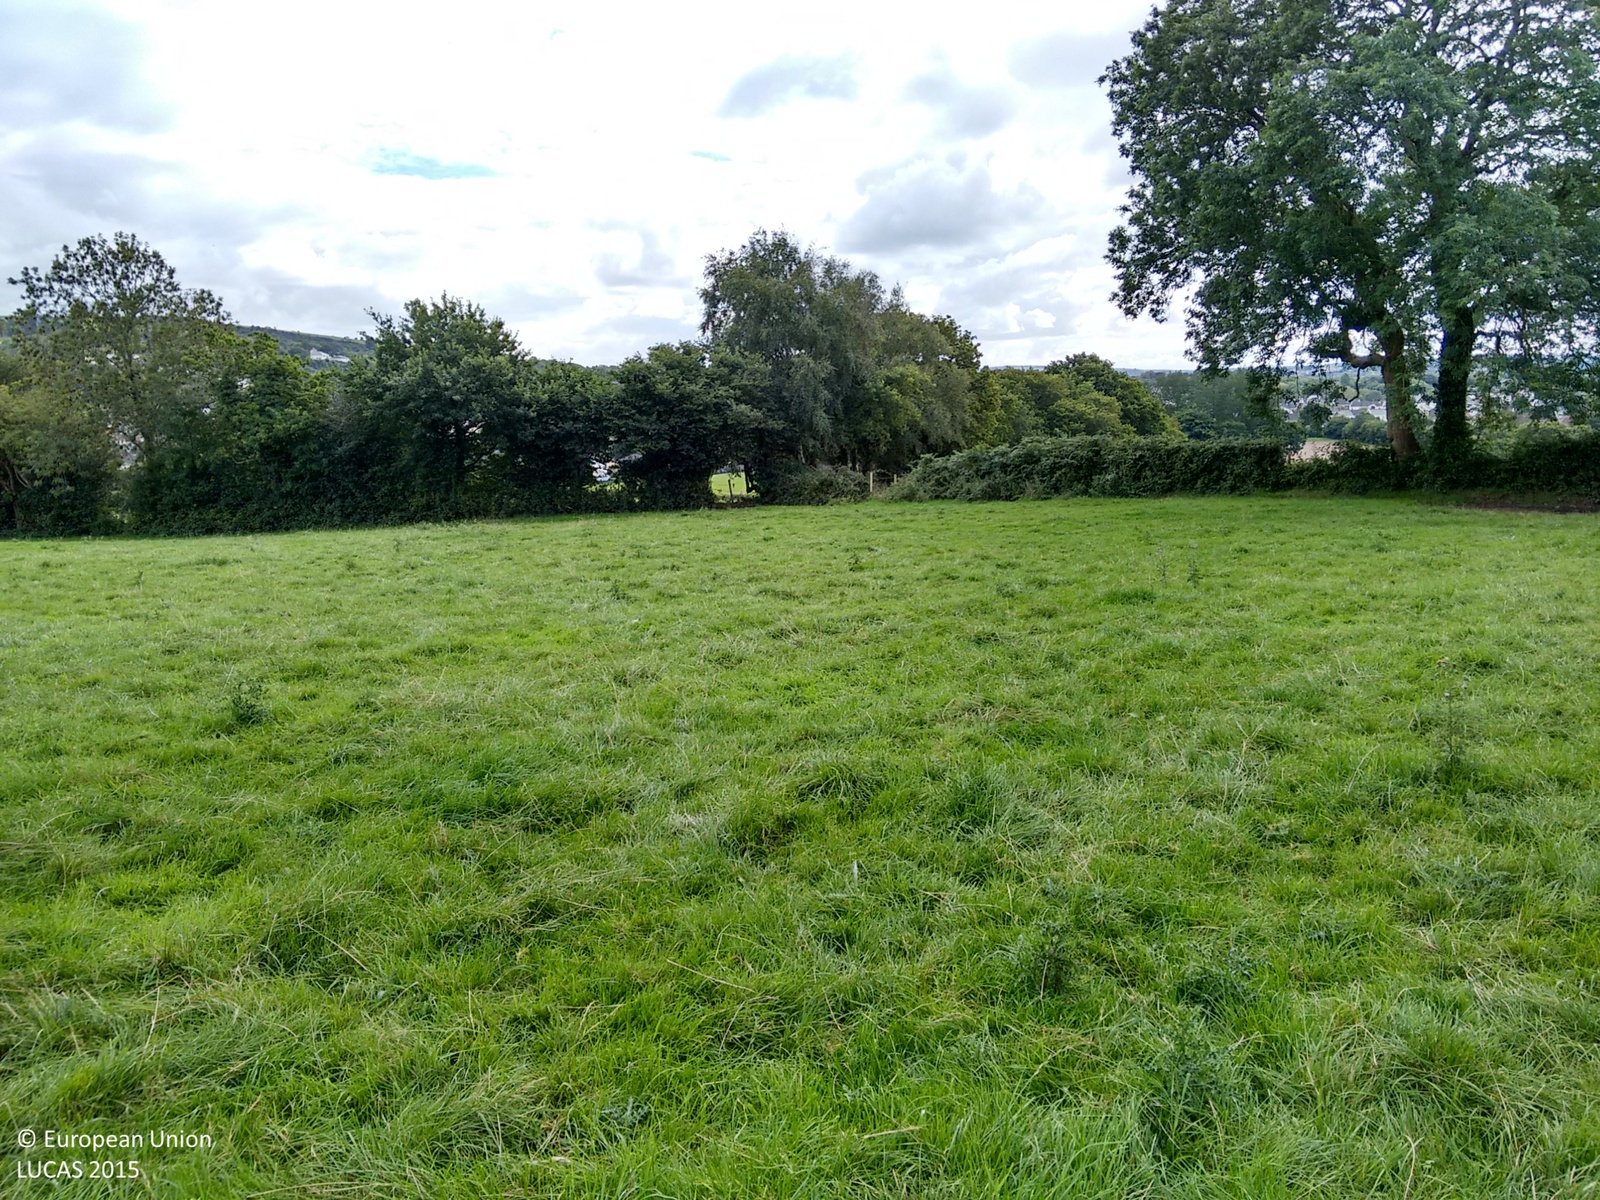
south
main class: Grassland
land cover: Grassland without tree/shrub cover
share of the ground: > 75 %
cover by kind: herbaceous plants 100 %
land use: Agriculture (excluding fallow land and kitchen gardens)
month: September
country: GB
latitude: 51.7206
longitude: -4.0354
